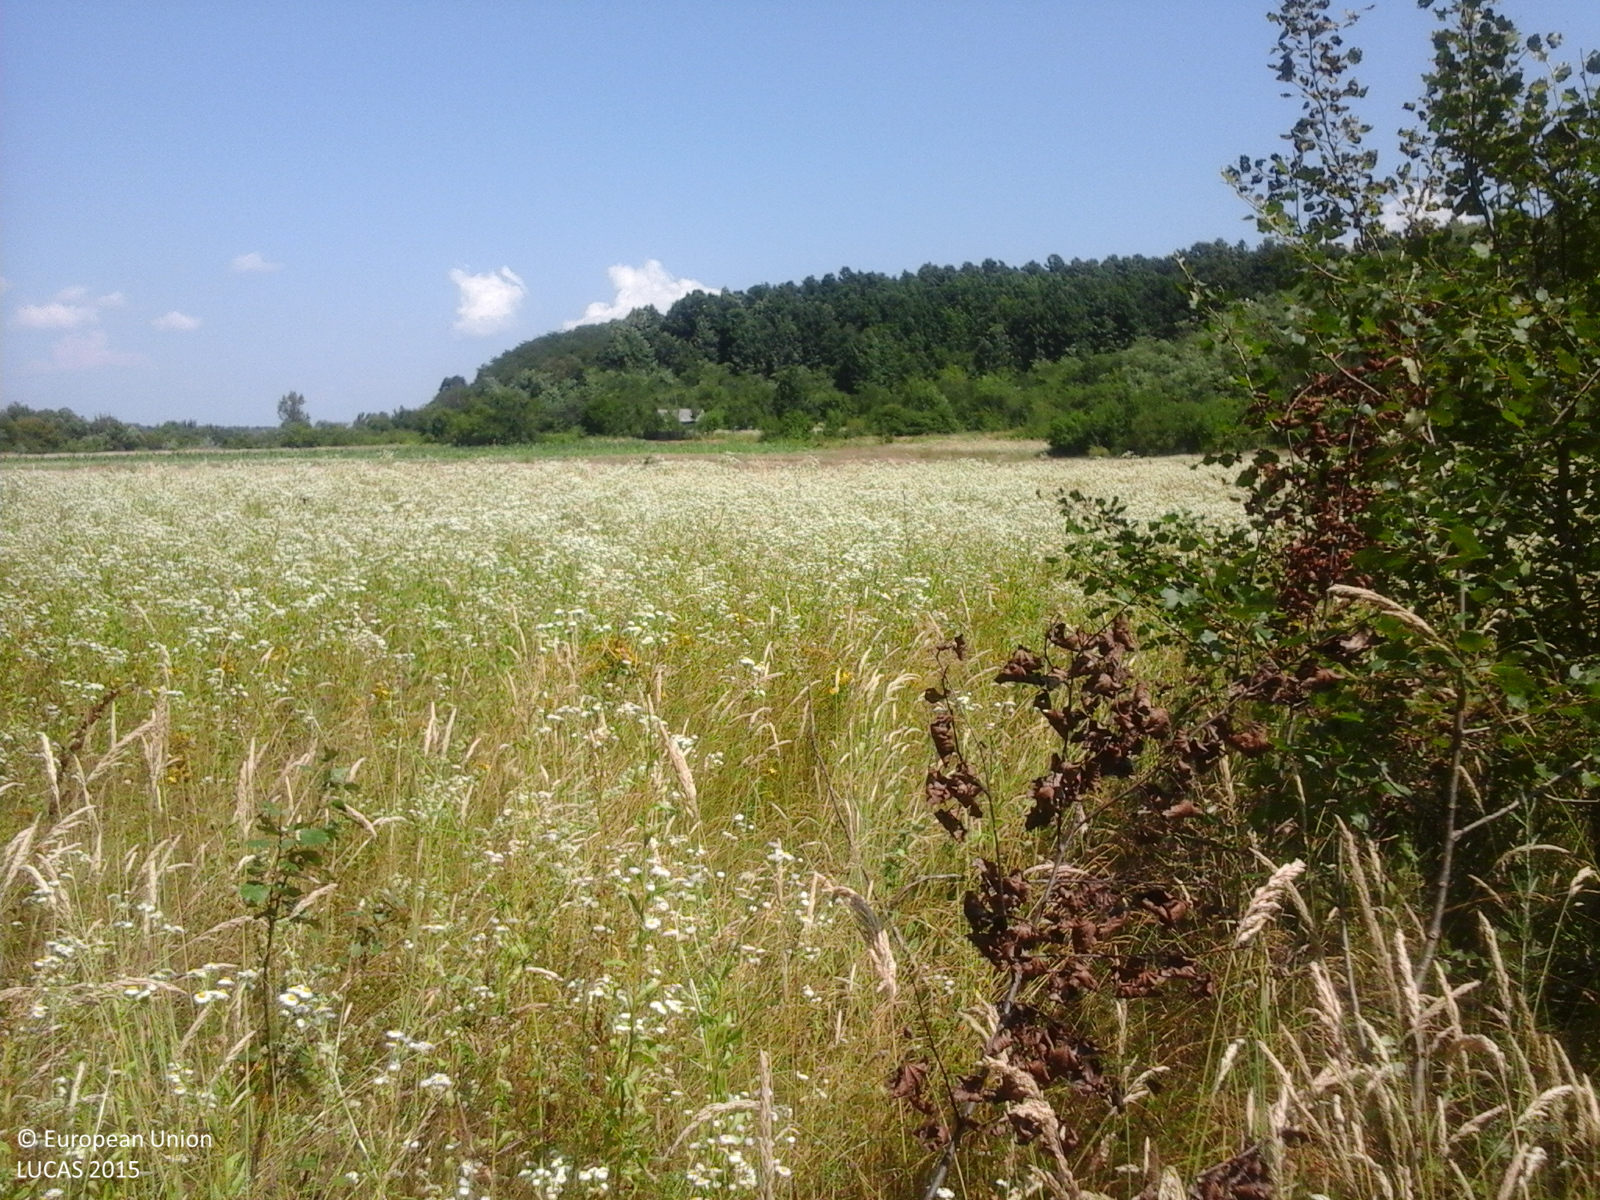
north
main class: Woodland
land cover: Broadleaved woodland
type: non-riverine alder, birch or aspen forest
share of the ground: > 75 %
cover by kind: broadleaved forest trees 100 %
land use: Forestry
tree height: > 5 m
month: July
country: RO
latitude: 44.8045
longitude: 24.5251
